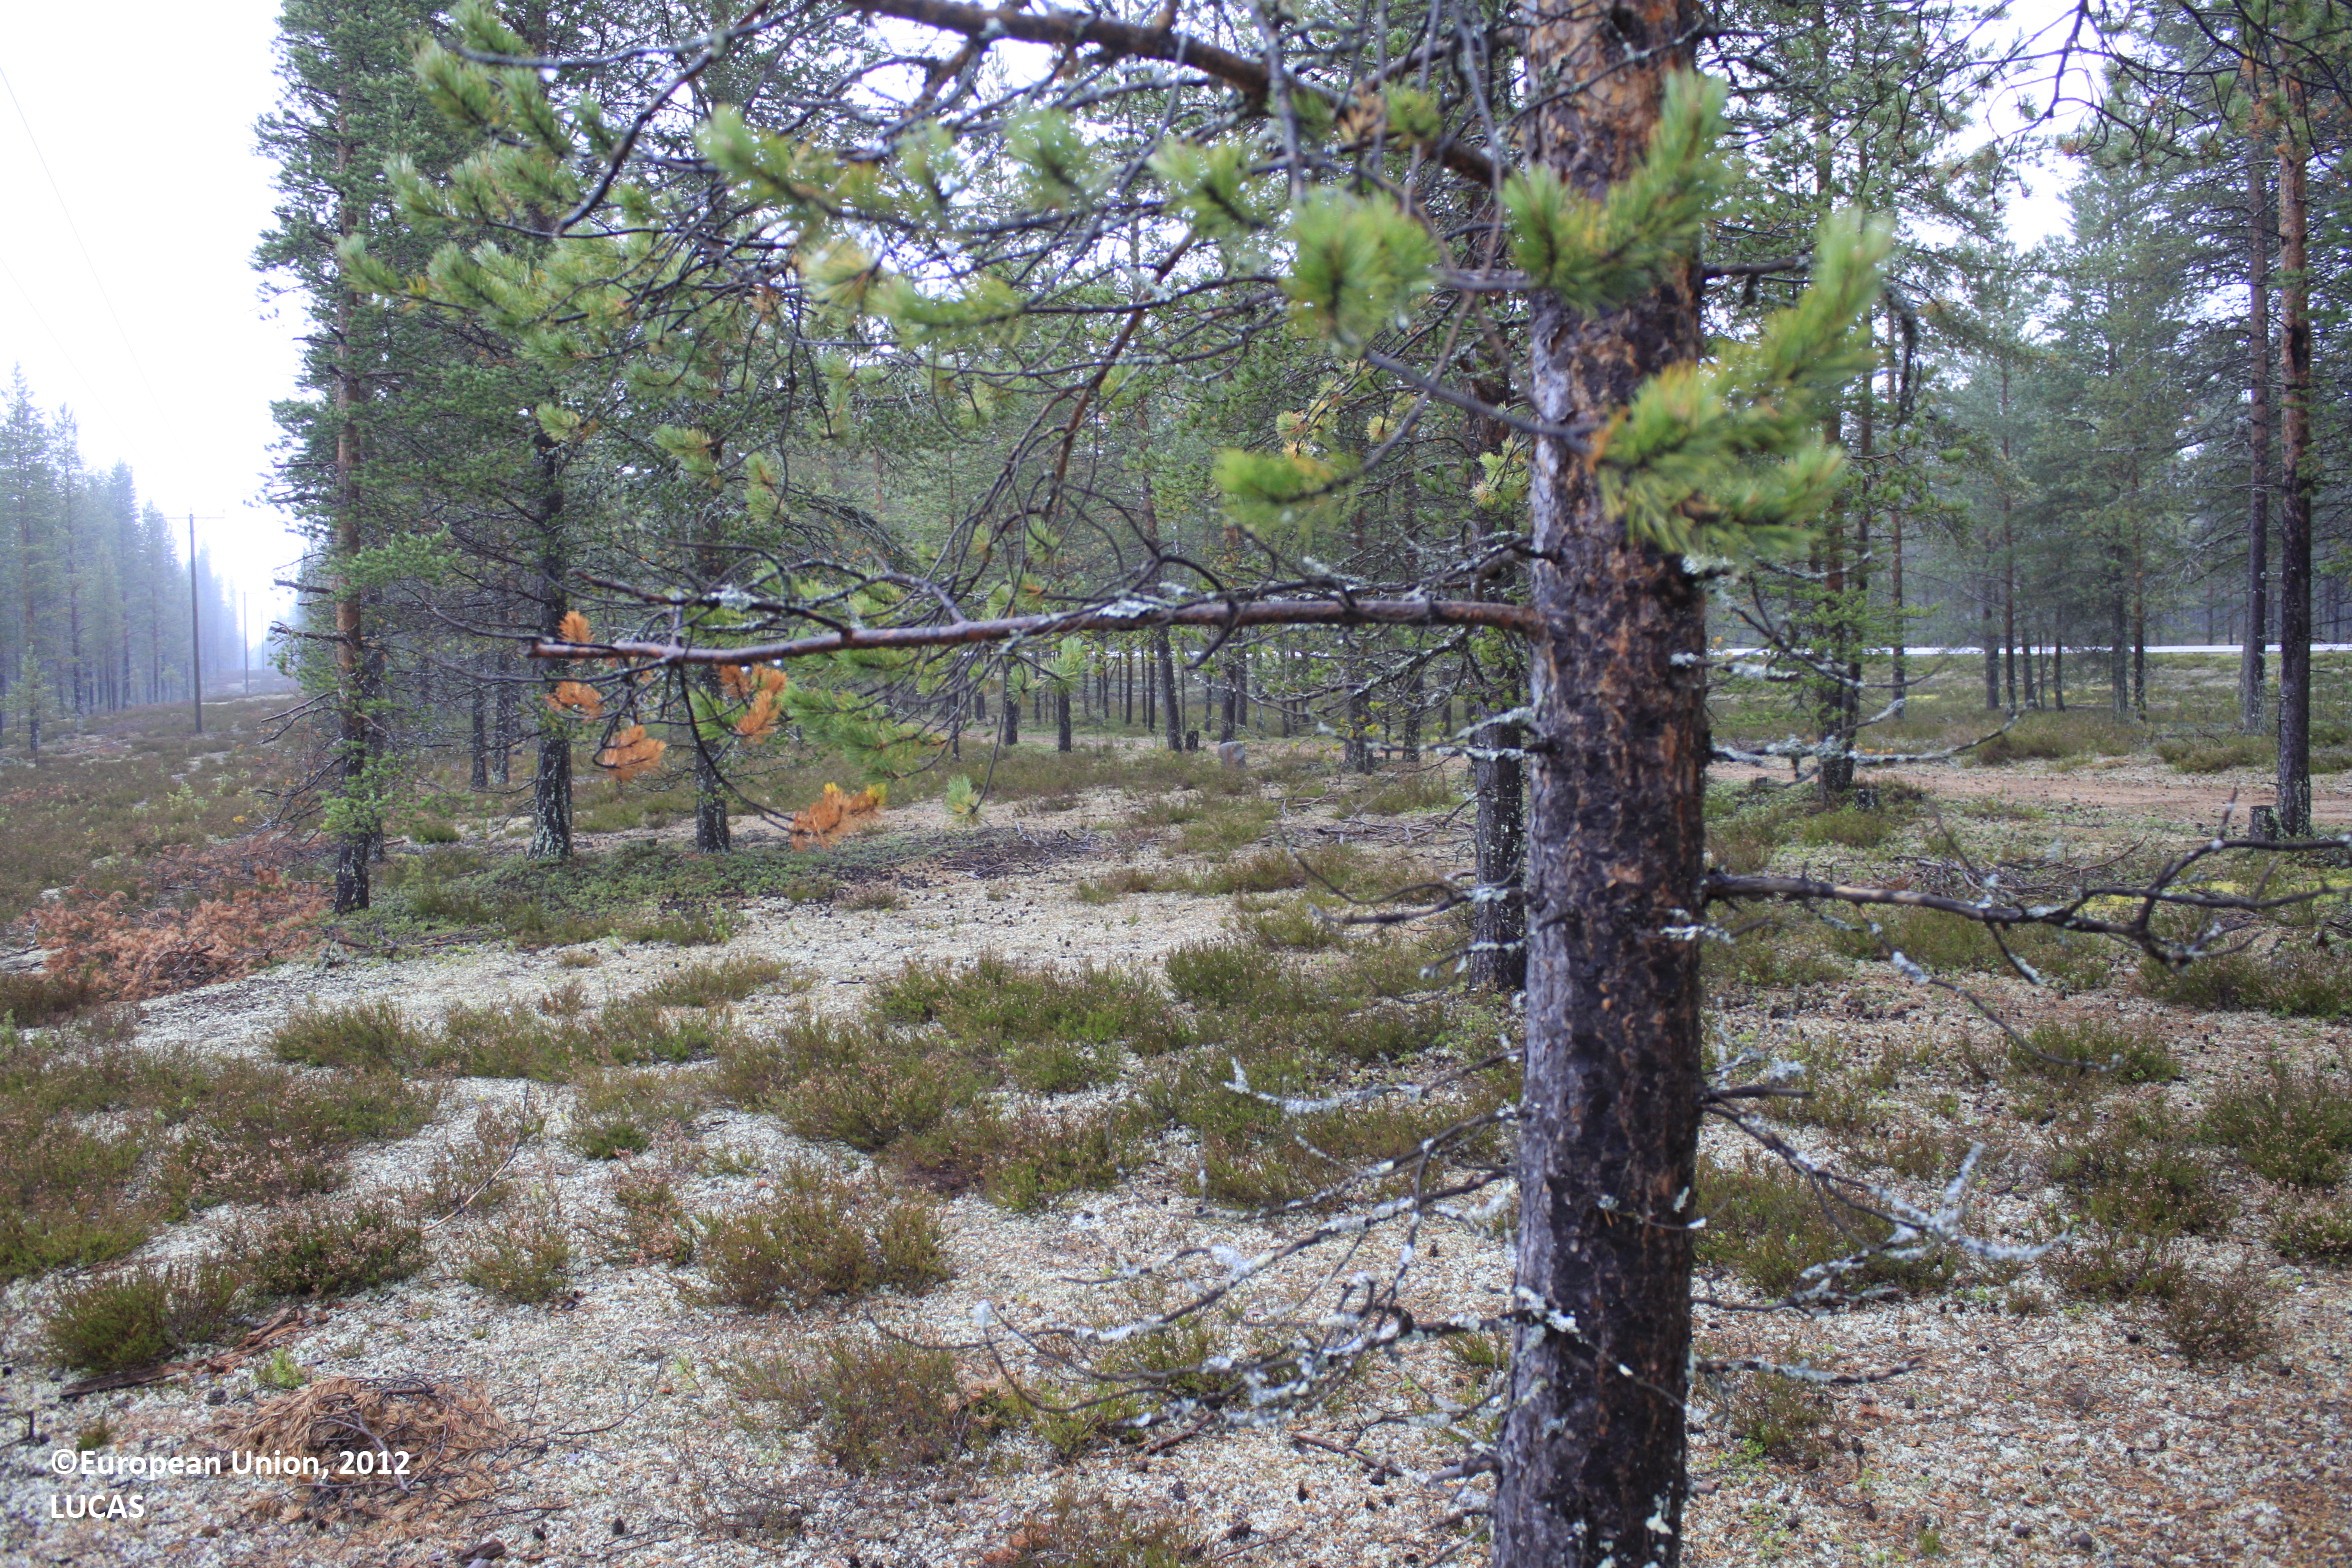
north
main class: Woodland
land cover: Pine dominated coniferous woodland
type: boreal forest
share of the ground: 25 - 50 %
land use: Forestry
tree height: > 5 m
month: September
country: FI
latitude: 65.6625
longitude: 27.3679
